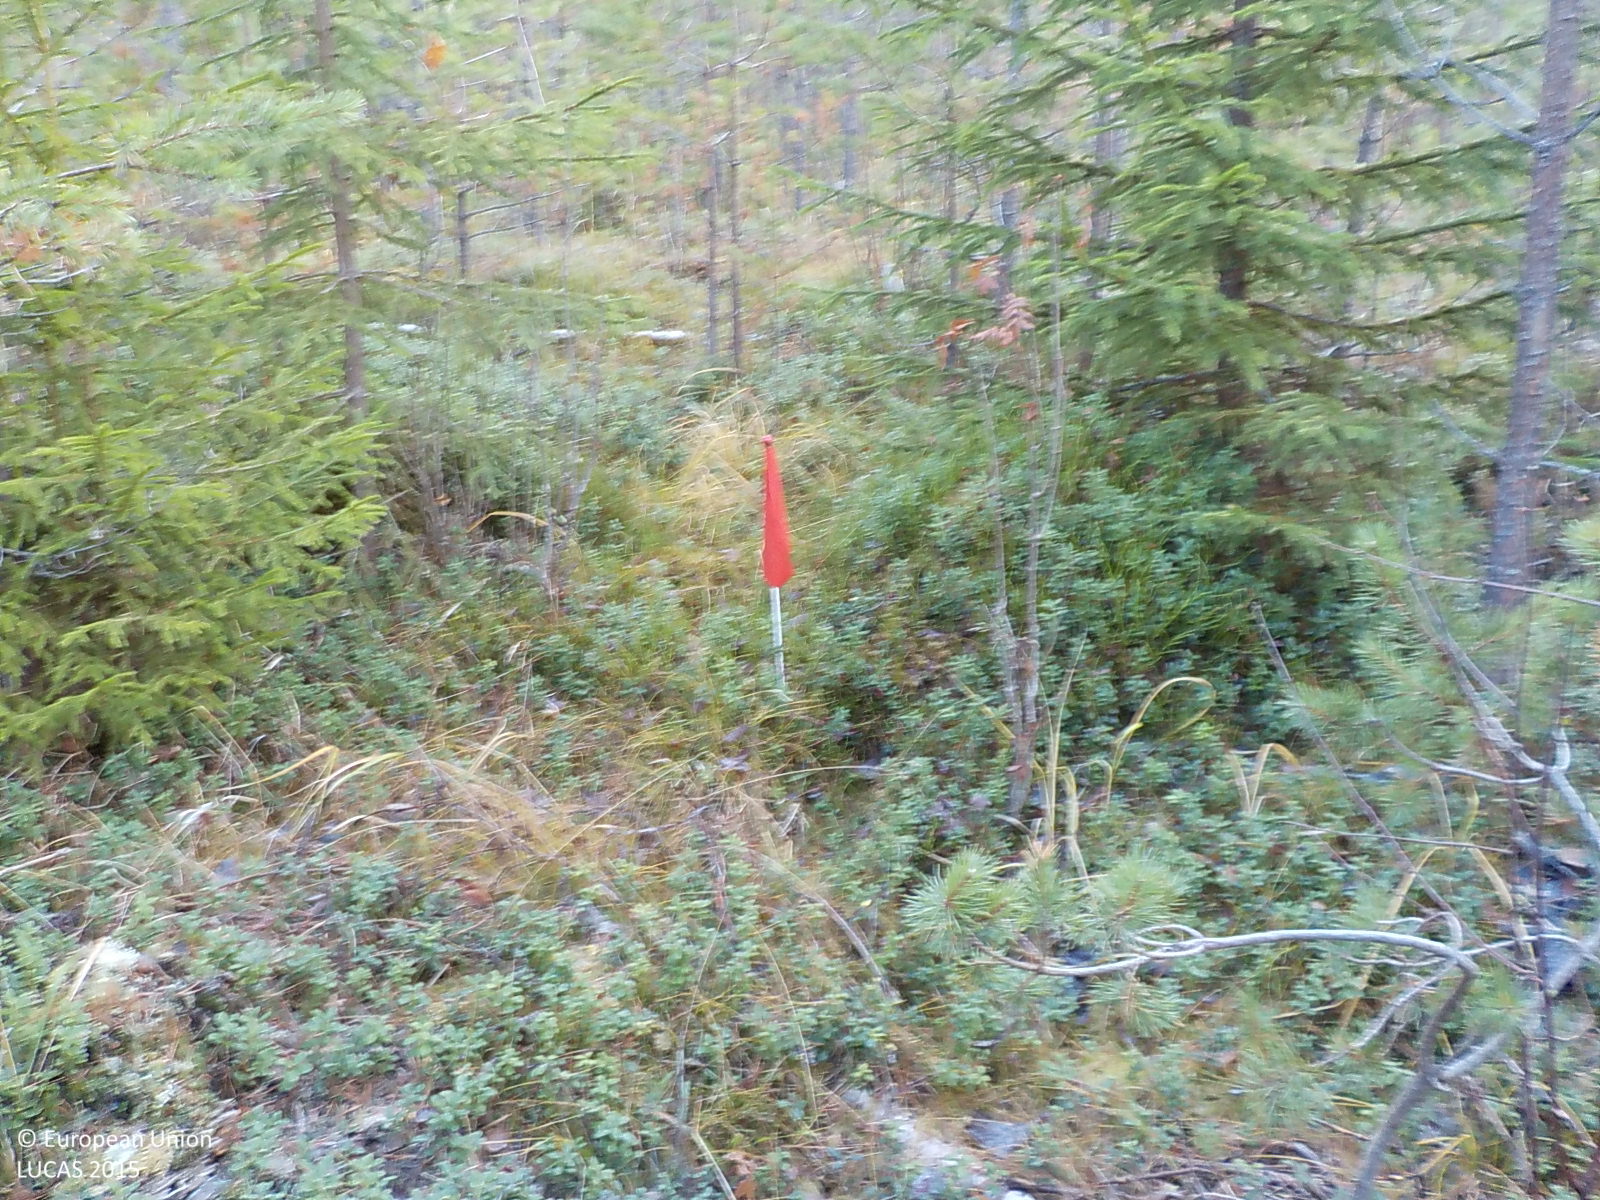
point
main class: Woodland
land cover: Pine dominated coniferous woodland
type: boreal forest
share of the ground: > 75 %
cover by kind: coniferous forest trees 85 %, shrubs 10 %, herbaceous plants 5 %
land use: Forestry
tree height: > 5 m
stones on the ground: < 10 %
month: October
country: SE
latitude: 63.3379
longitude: 16.9858
